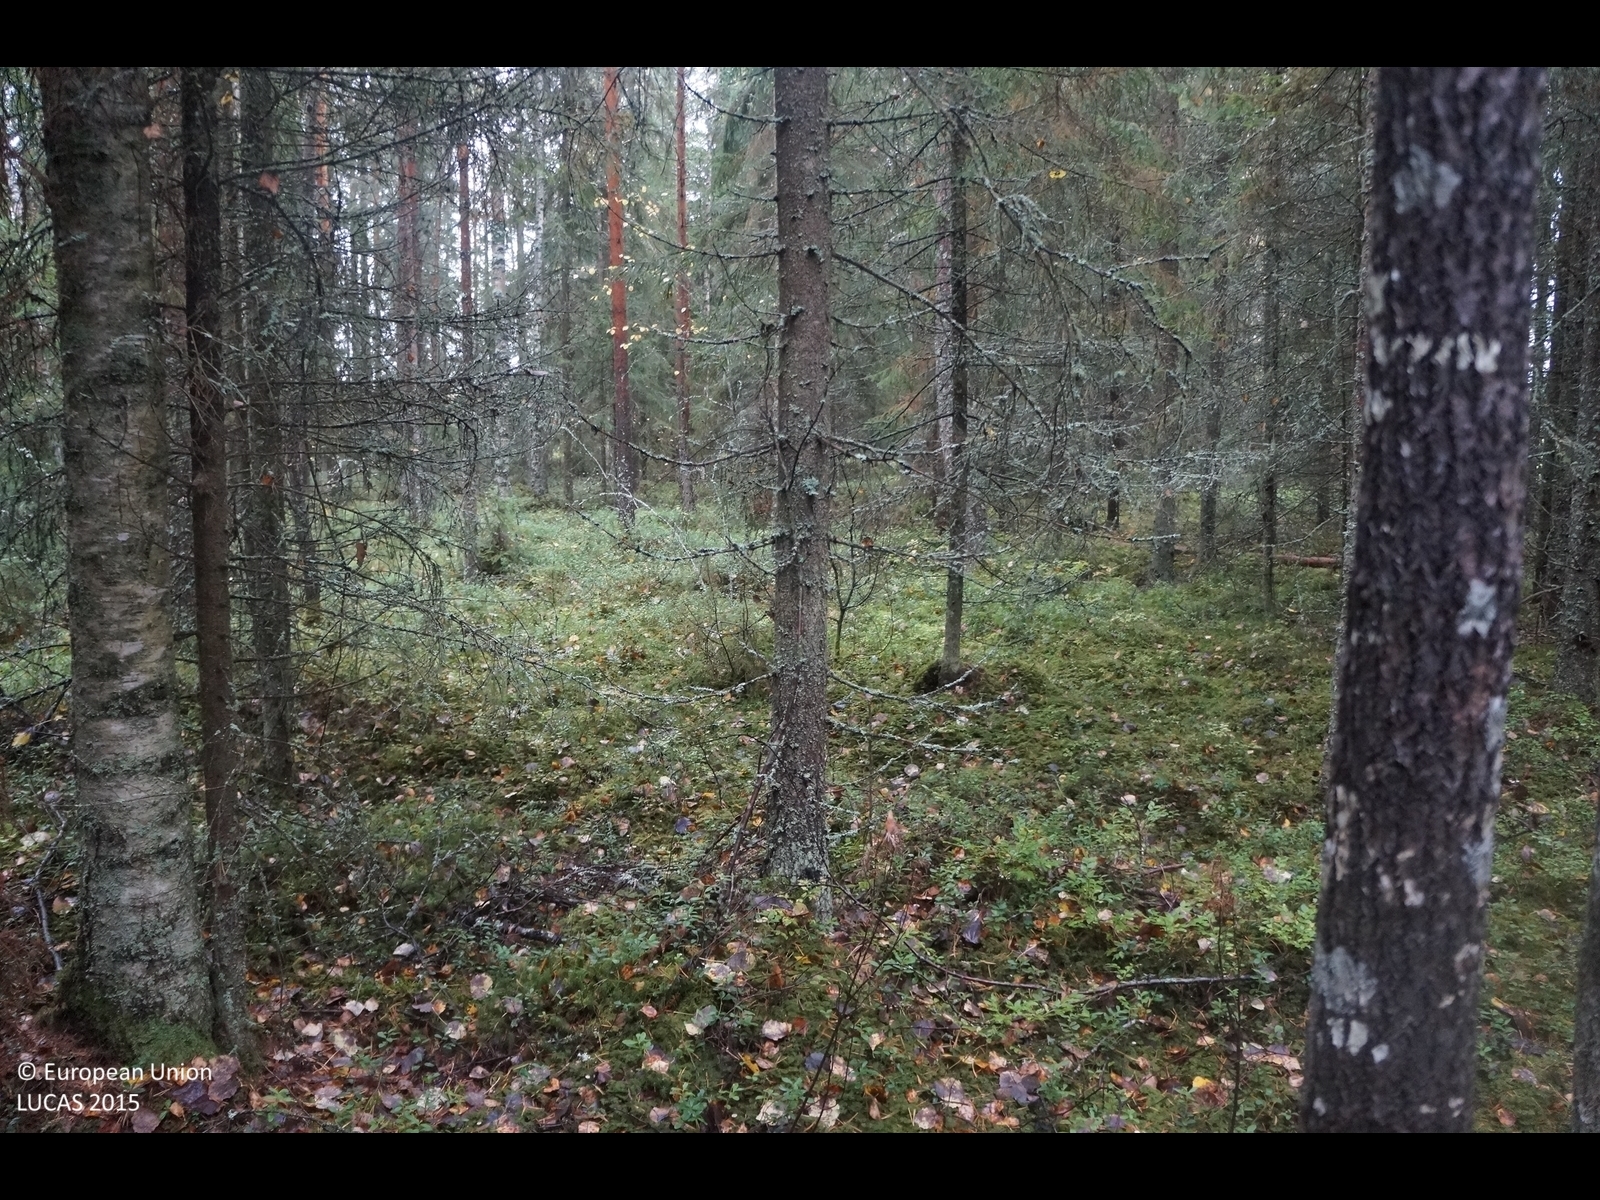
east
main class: Woodland
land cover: Spruce dominated mixed woodland
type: boreal forest
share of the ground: 50 - 75 %
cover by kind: coniferous forest trees 50 %, broadleaved forest trees 20 %, shrubs 15 %, lichens and mosses 15 %
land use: Forestry
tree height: > 5 m
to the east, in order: Spruce dominated mixed woodland; Ditches and canals; Shruby margins; Tracks; Ditches and canals; Shruby margins; Temporary grasslands; Shruby margins; Ditches and canals; Shruby margins; Temporary grasslands; Electric lines; Temporary grasslands; Shruby margins; Ditches and canals; Shruby margins; Temporary grasslands; Shruby margins; Ditches and canals; Shruby margins; Temporary grasslands; Shruby margins; Ditches and canals; Shruby margins; Paved roads, cycling and walking lanes; Shruby margins; Ditches and canals; Electric lines; Broadleaved woodland
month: September
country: FI
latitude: 64.1213
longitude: 24.4258
